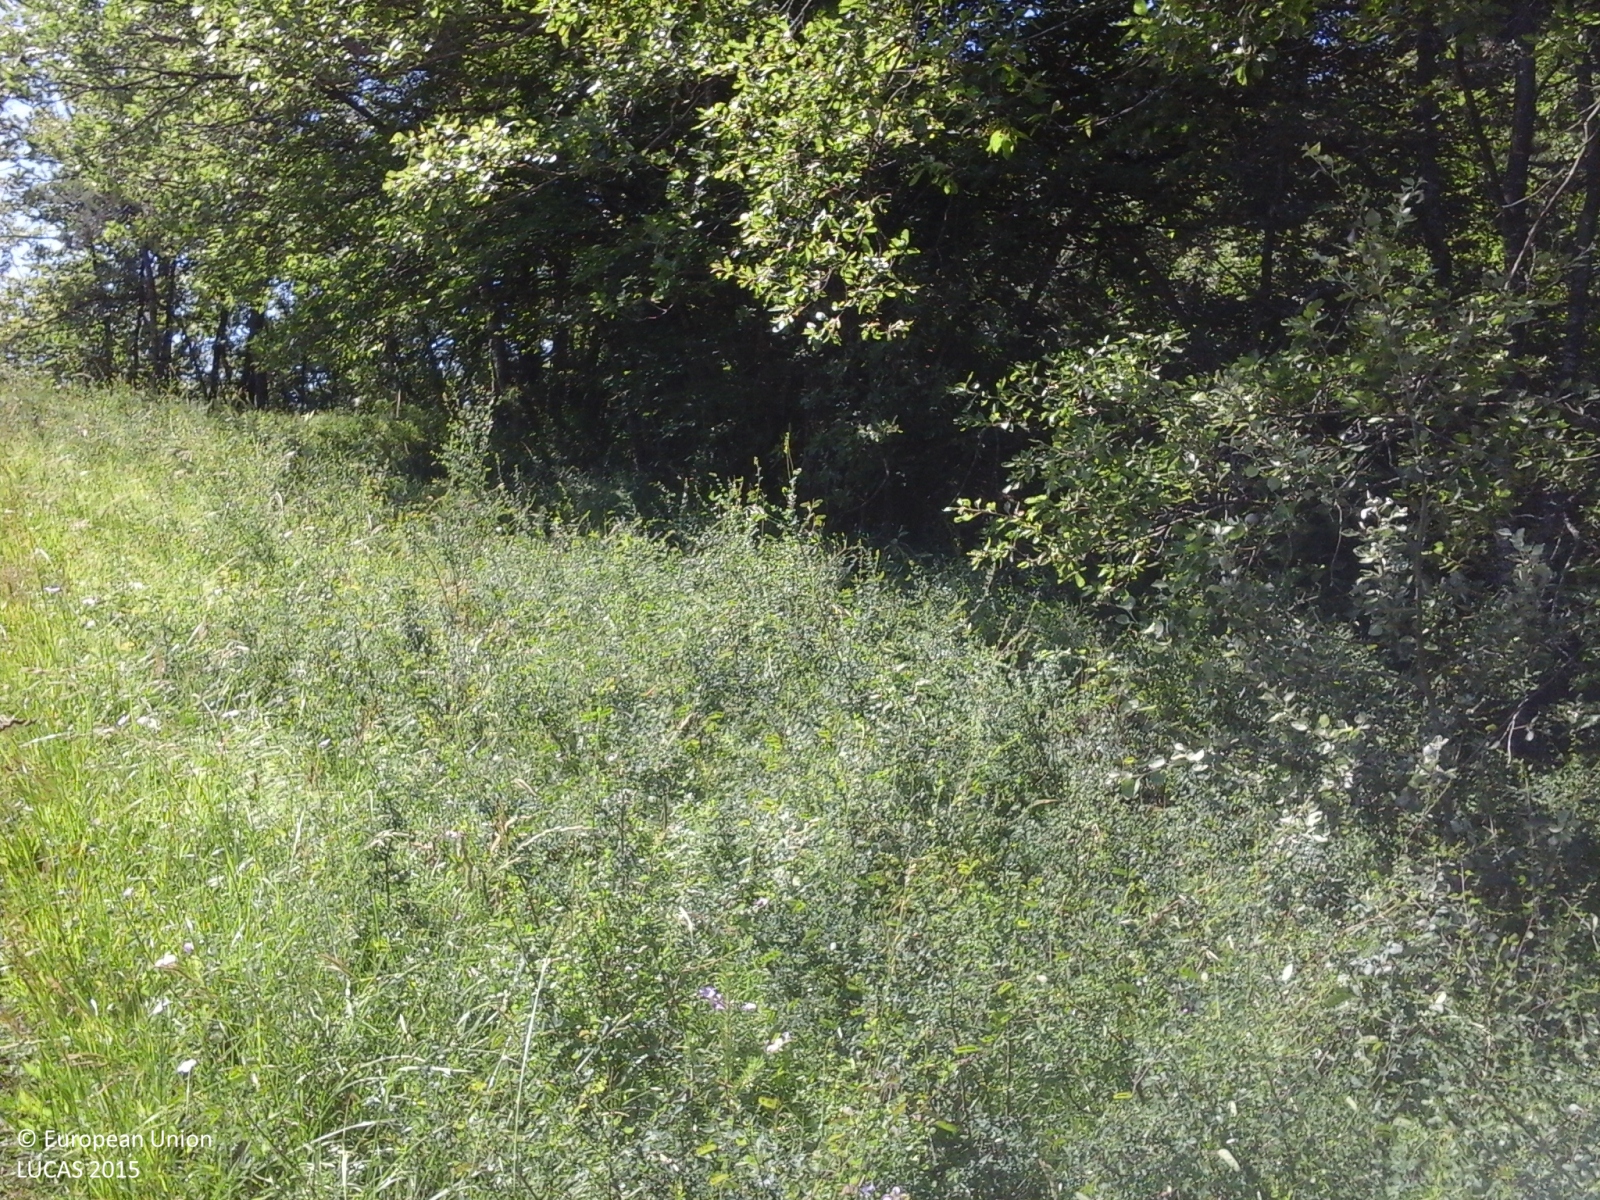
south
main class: Woodland
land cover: Broadleaved woodland
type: thermophilous deciduous forest
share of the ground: > 75 %
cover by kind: broadleaved forest trees 100 %
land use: Forestry
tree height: > 5 m
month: June
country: IT
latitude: 44.5127
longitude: 10.1883
